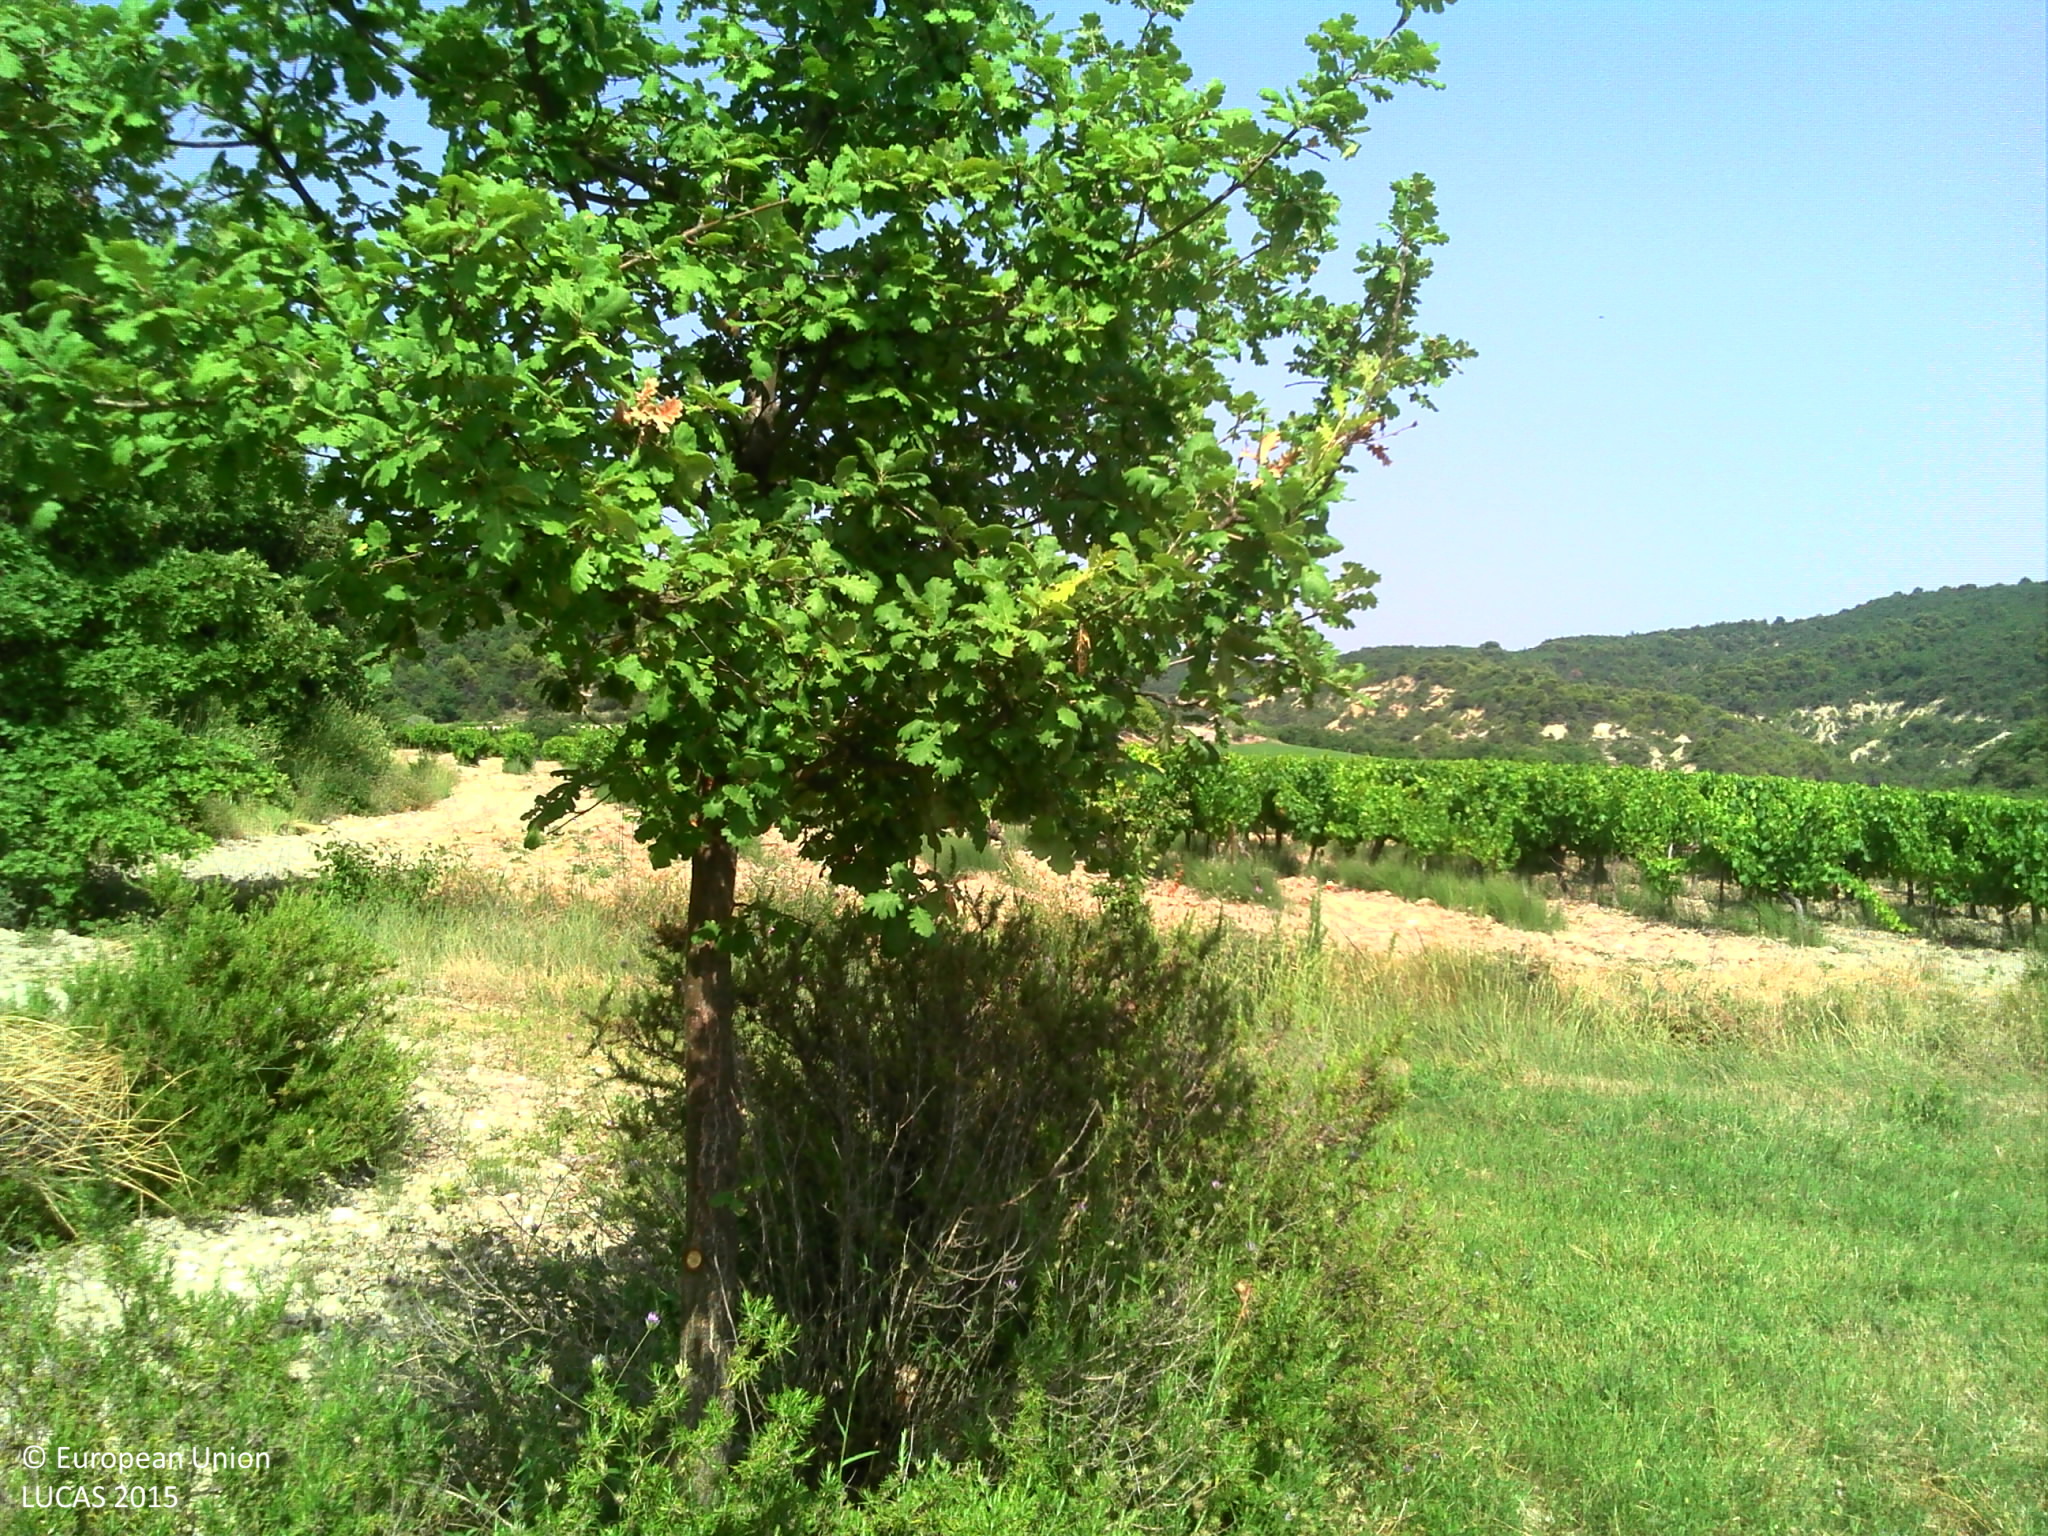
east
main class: Cropland
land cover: Other fresh vegetables
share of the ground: 25 - 50 %
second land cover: Spontaneously vegetated surfaces
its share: 50 - 75 %
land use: Agriculture (excluding fallow land and kitchen gardens)
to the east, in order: Other fresh vegetables; Spontaneously vegetated surfaces; Ditches and canals; Grass margins; Vineyards; Tracks; Shruby margins; Other leguminous and mixtures for fodder; Grass margins; Tracks; Broadleaved woodland; Shruby margins; Permanent industrial crops
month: July
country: FR
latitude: 44.3770
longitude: 5.0498
